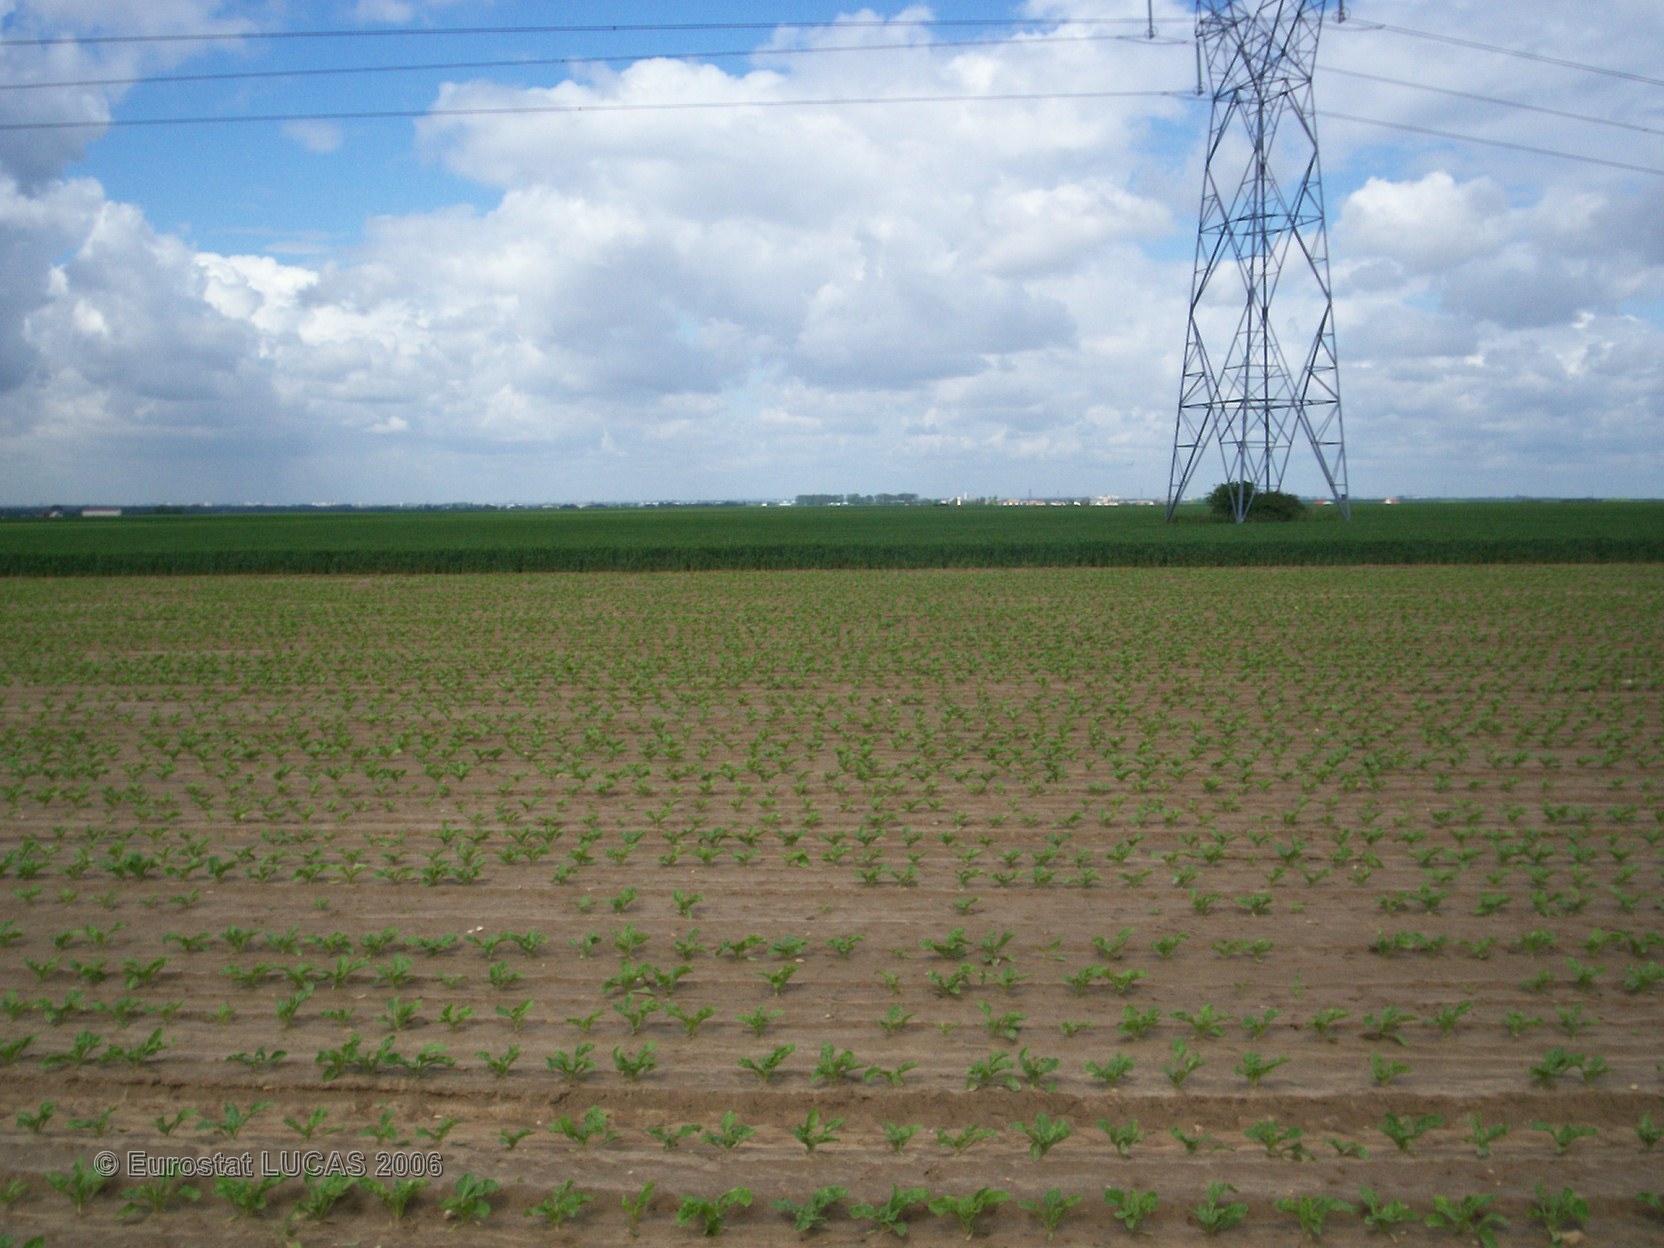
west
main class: Cropland
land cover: Sugar beet
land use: Agriculture (excluding fallow land and kitchen gardens)
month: May
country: FR
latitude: 48.9772
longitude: 2.7350
